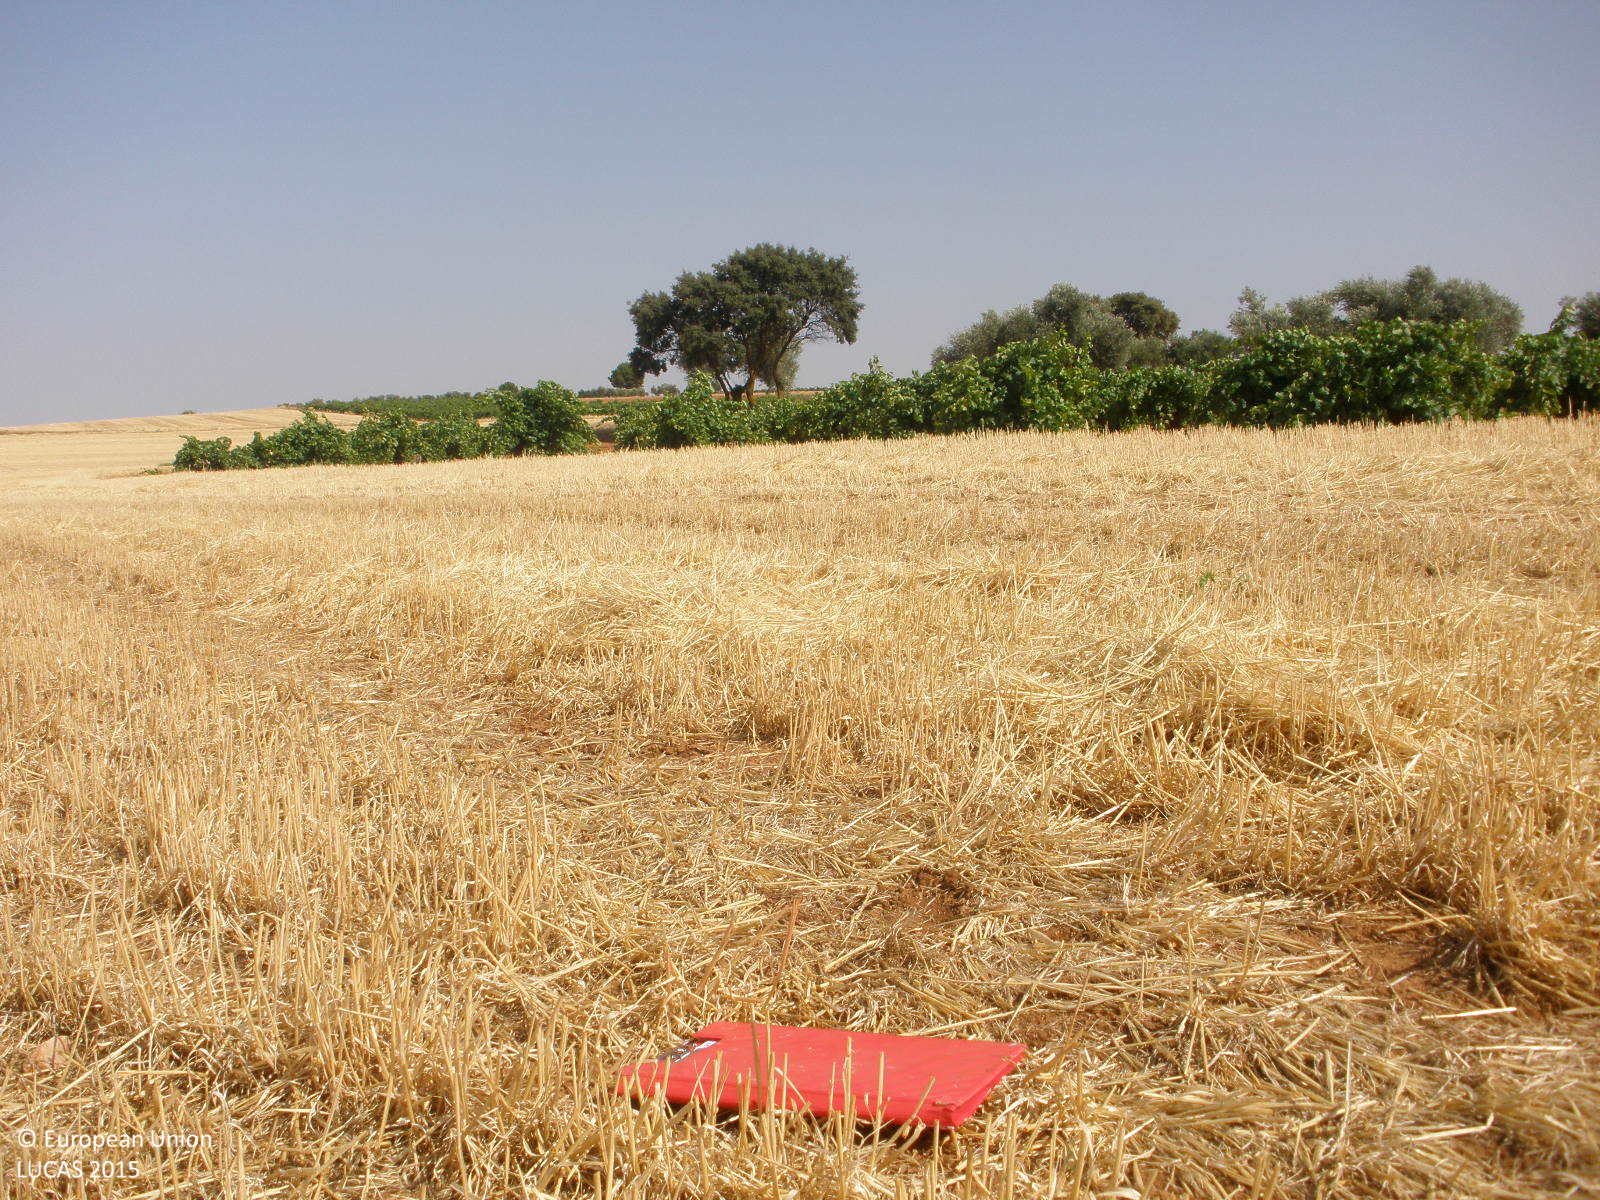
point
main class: Cropland
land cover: Barley
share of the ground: < 10 %
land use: Agriculture (excluding fallow land and kitchen gardens)
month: July
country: ES
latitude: 39.9305
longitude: -3.2599
